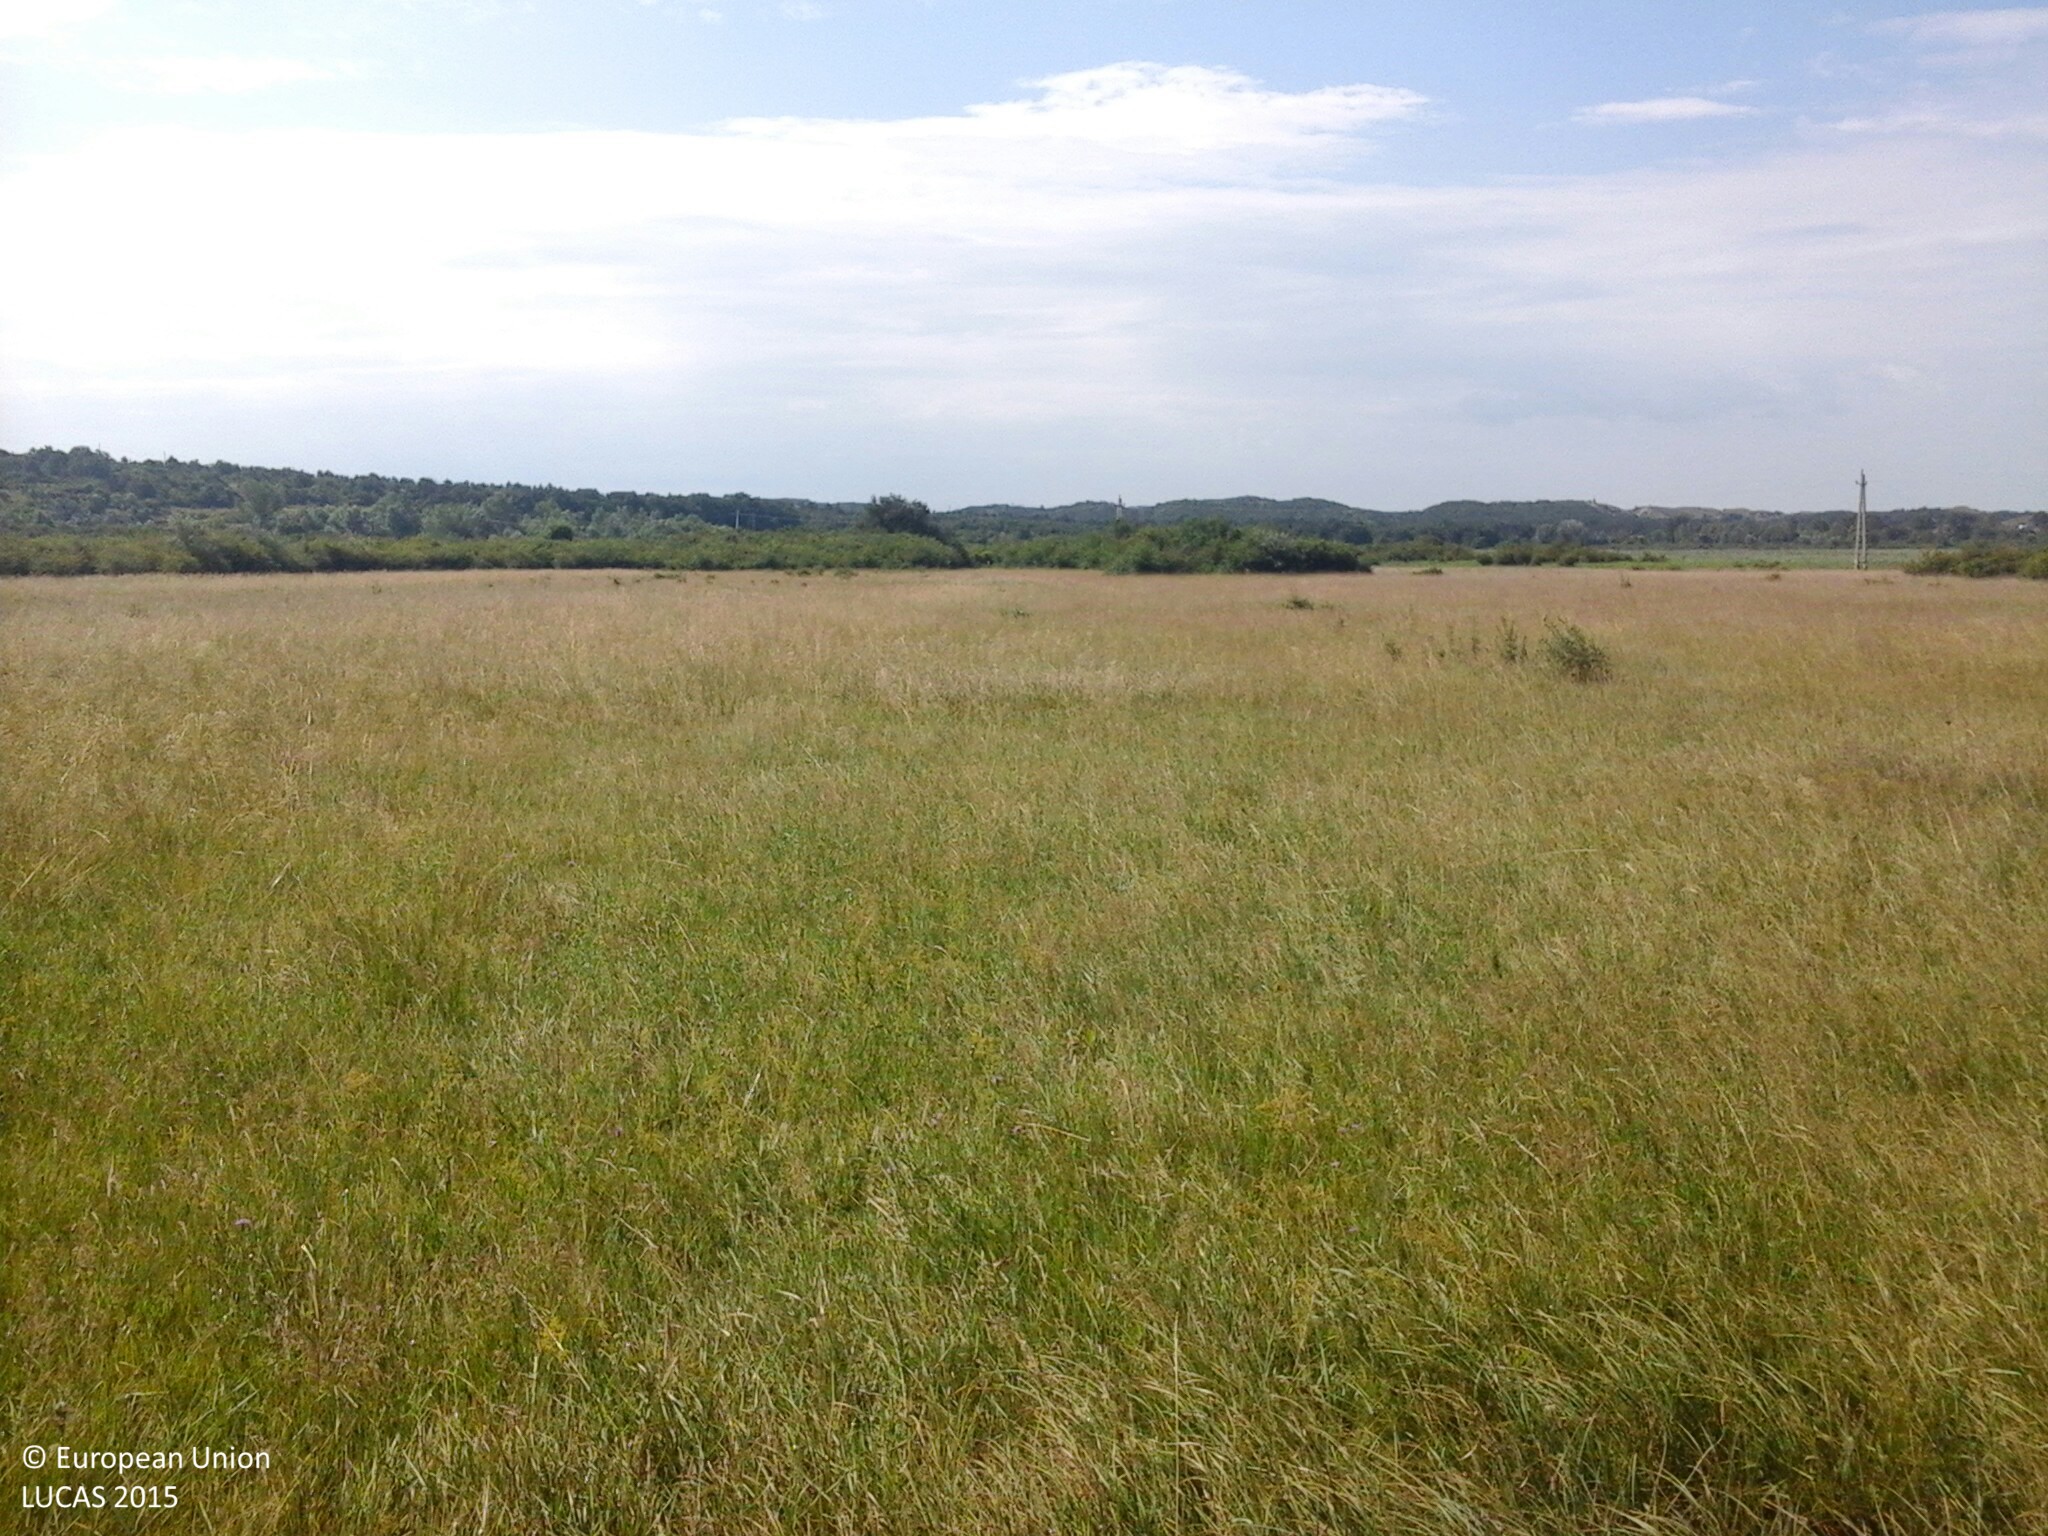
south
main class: Grassland
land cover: Grassland without tree/shrub cover
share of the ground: > 75 %
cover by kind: herbaceous plants 100 %
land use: Agriculture (excluding fallow land and kitchen gardens)
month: July
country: HU
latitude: 47.1836
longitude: 18.0997
